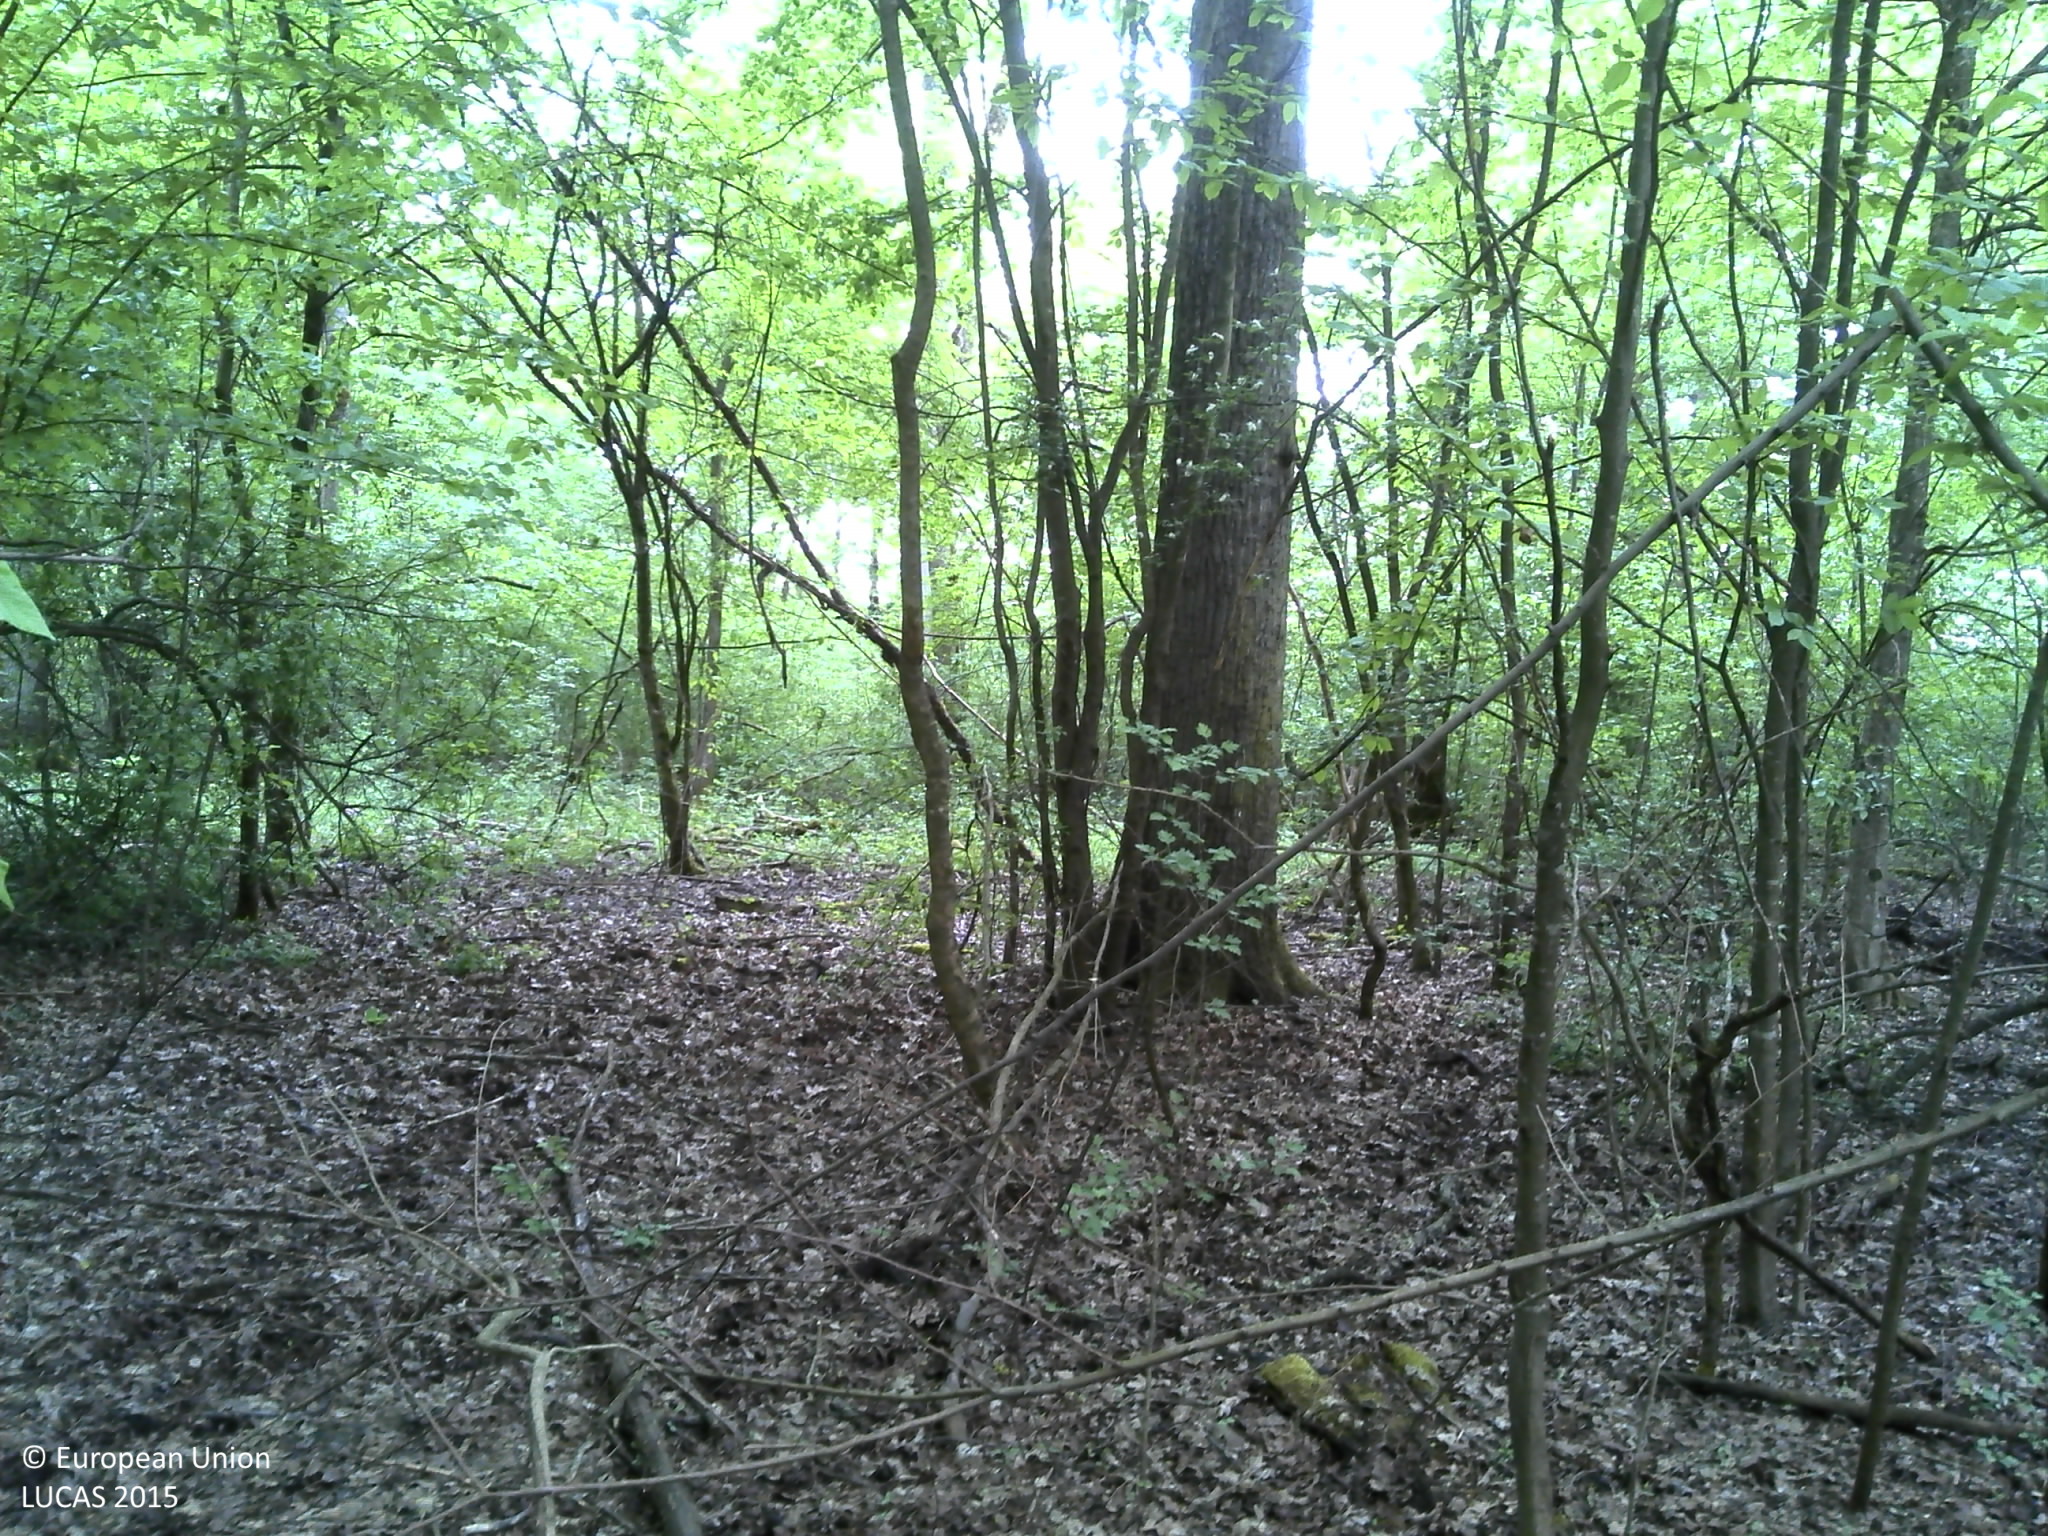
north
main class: Woodland
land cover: Broadleaved woodland
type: mesophytic deciduous forest
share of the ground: > 75 %
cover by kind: broadleaved forest trees 100 %
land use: Forestry
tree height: > 5 m
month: April
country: HR
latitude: 45.0304
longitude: 18.9808
